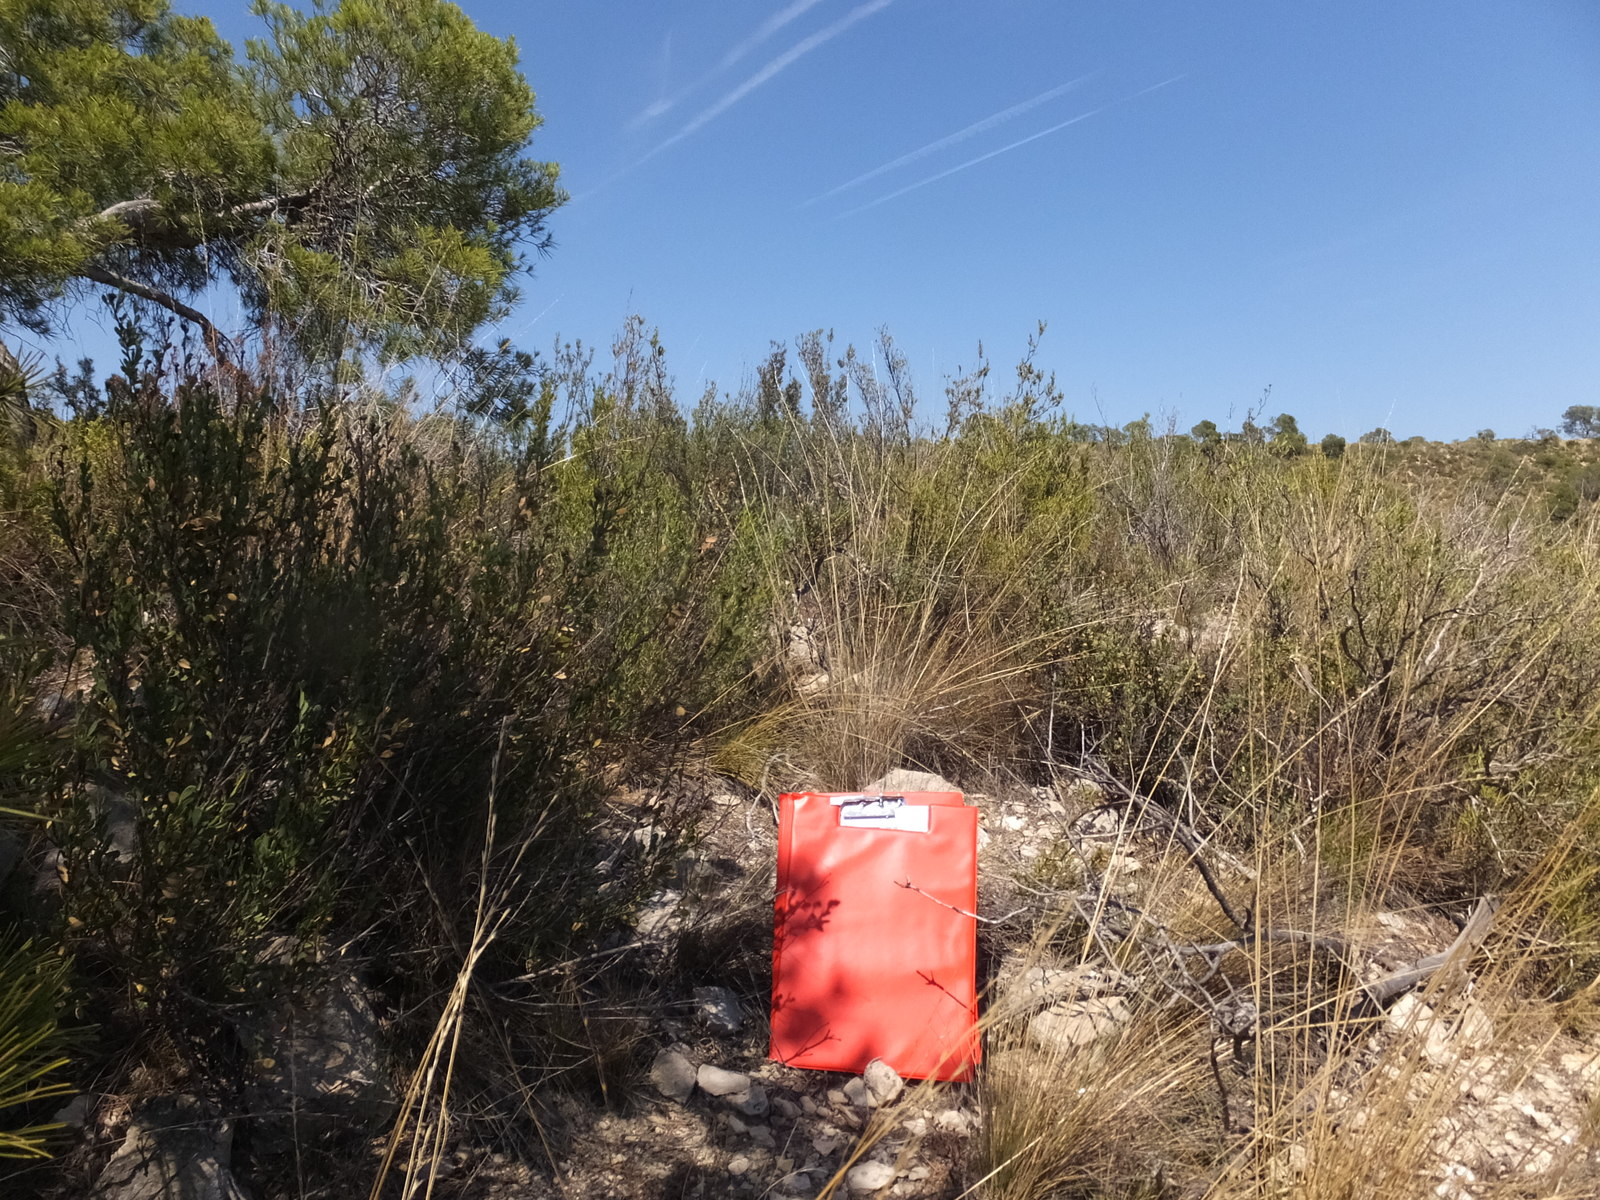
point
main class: Woodland
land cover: Pine dominated mixed woodland
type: coniferous forest of the mediterranean region
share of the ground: 25 - 50 %
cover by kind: shrubs 35 %, coniferous forest trees 25 %, herbaceous plants 25 %, broadleaved forest trees 15 %
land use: Forestry
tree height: > 5 m
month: June
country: ES
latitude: 41.3509
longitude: -0.0654
